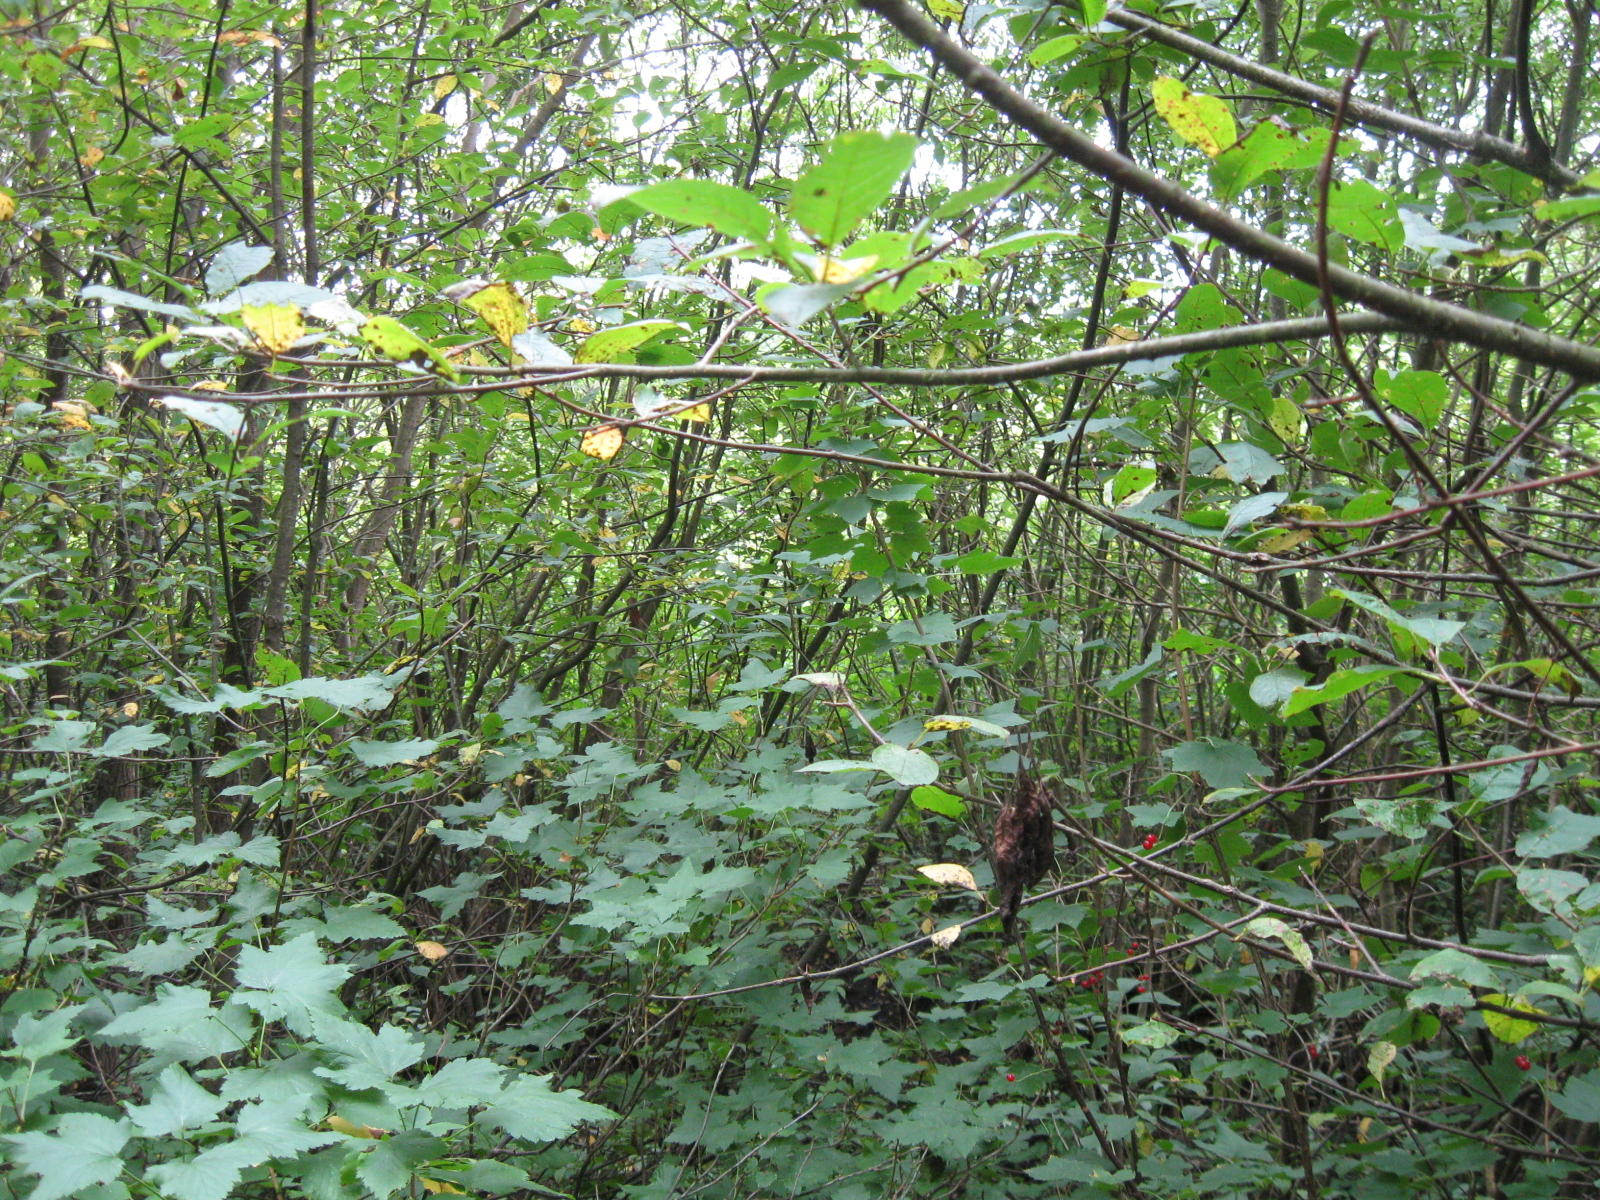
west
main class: Woodland
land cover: Broadleaved woodland
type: non-riverine alder, birch or aspen forest
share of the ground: > 75 %
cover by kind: broadleaved forest trees 85 %, herbaceous plants 10 %, coniferous forest trees 5 %
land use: Forestry
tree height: > 5 m
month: July
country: LT
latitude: 54.8611
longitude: 23.5581
